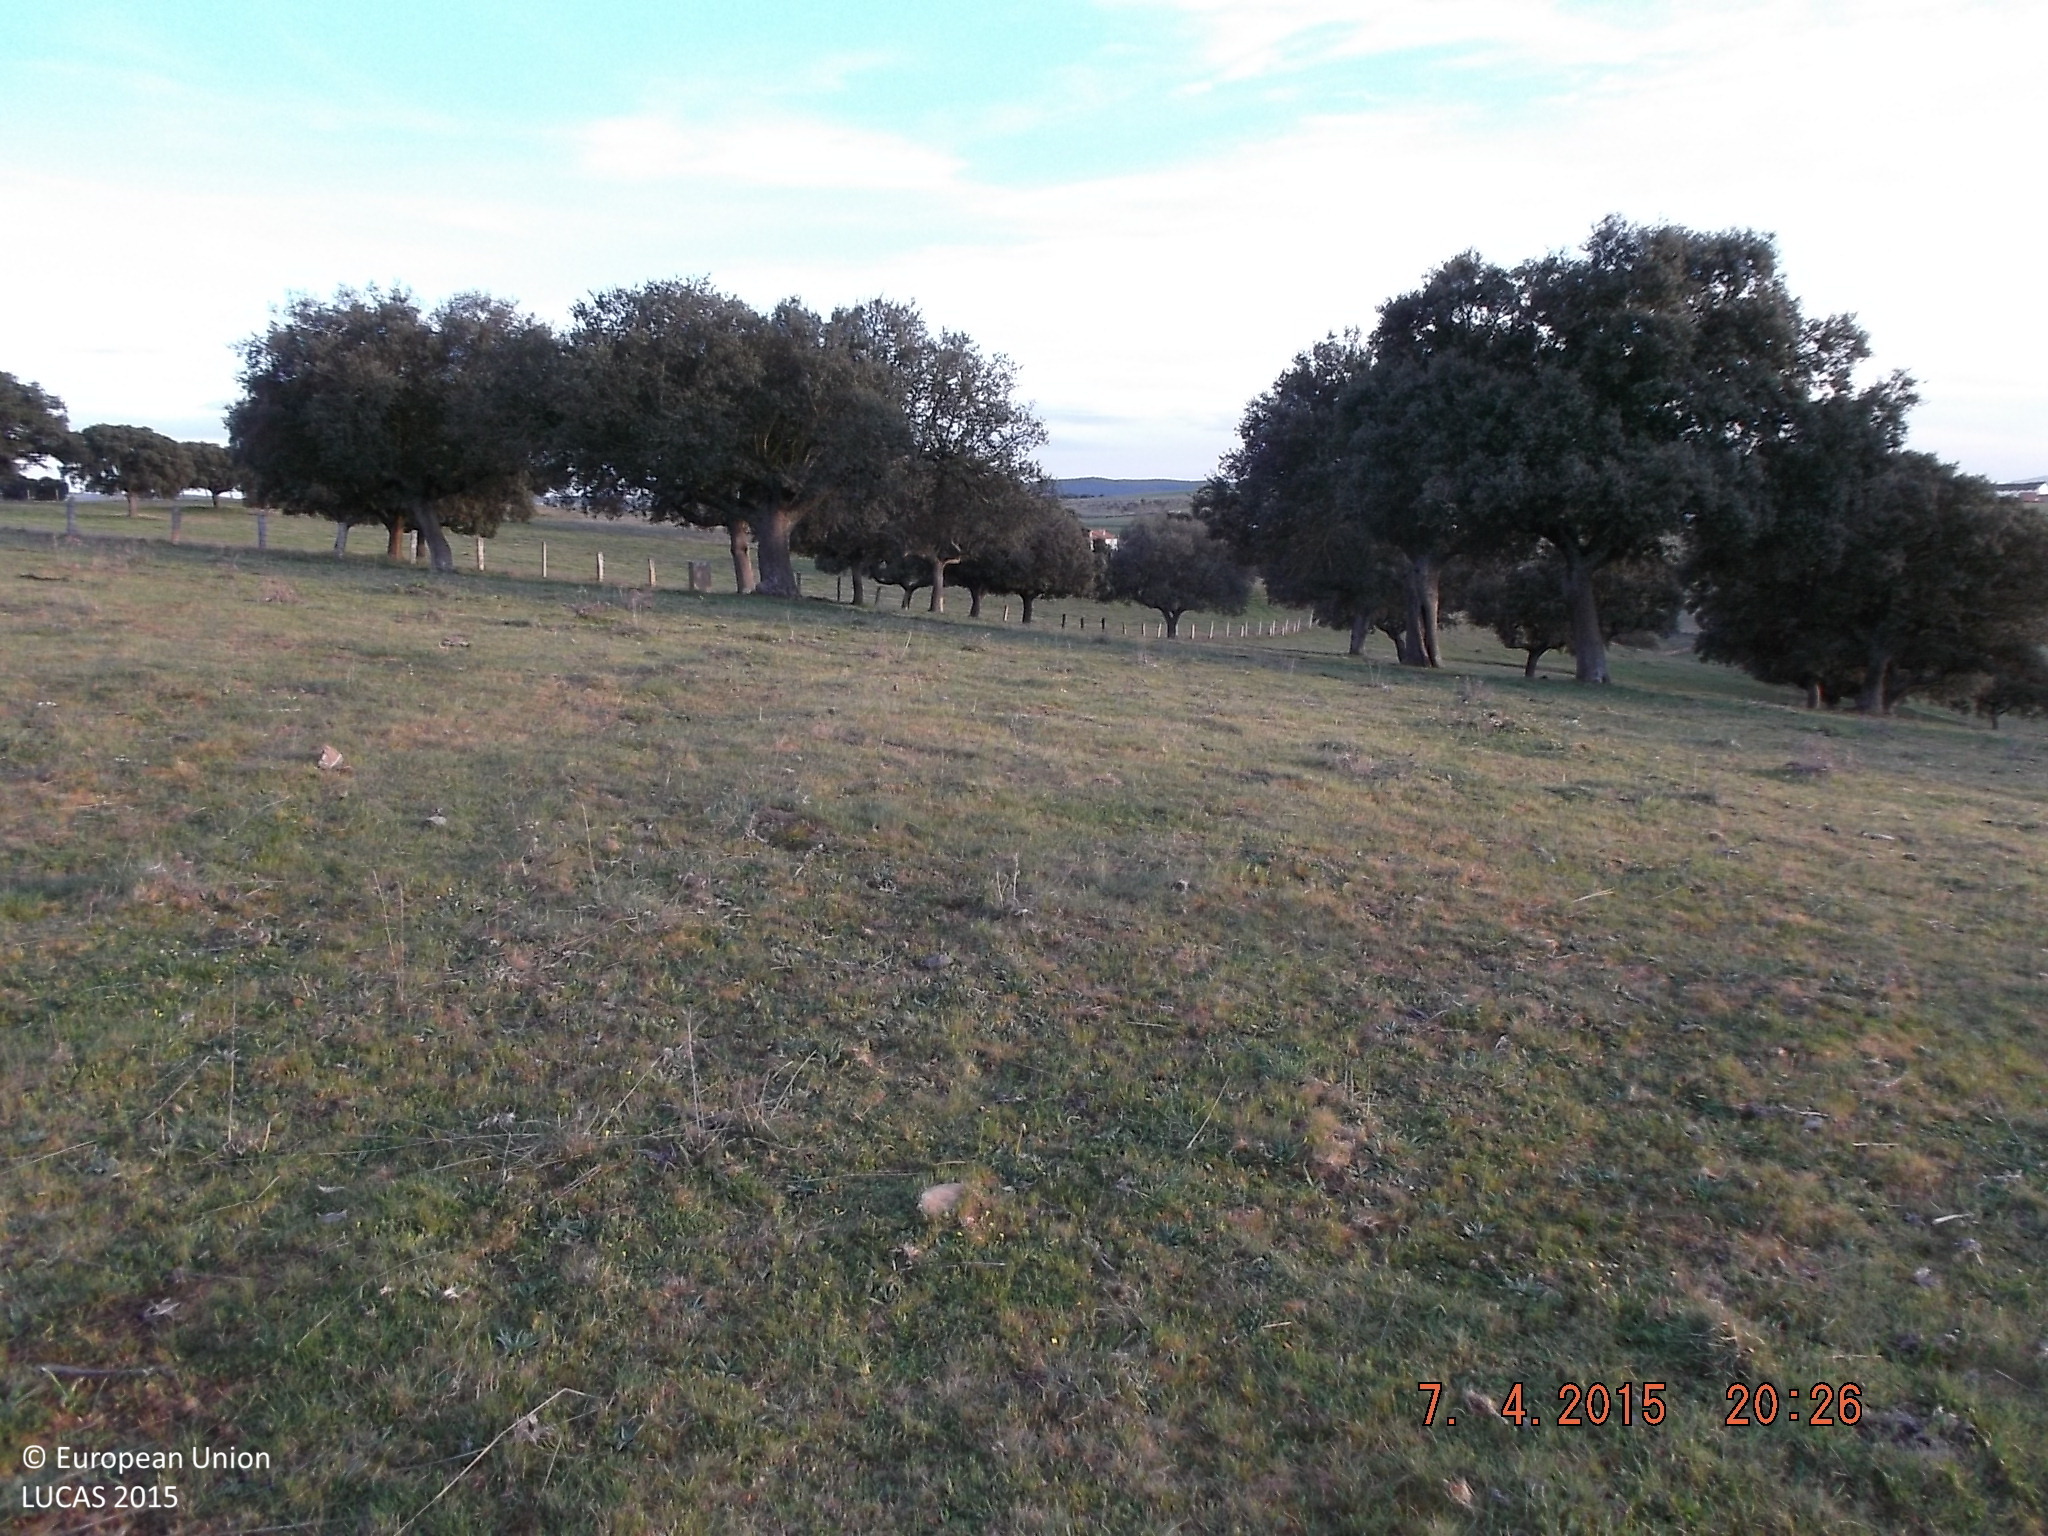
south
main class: Grassland
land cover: Grassland without tree/shrub cover
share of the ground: > 75 %
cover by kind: herbaceous plants 100 %
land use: Agriculture (excluding fallow land and kitchen gardens)
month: April
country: ES
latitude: 40.7862
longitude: -5.8752
